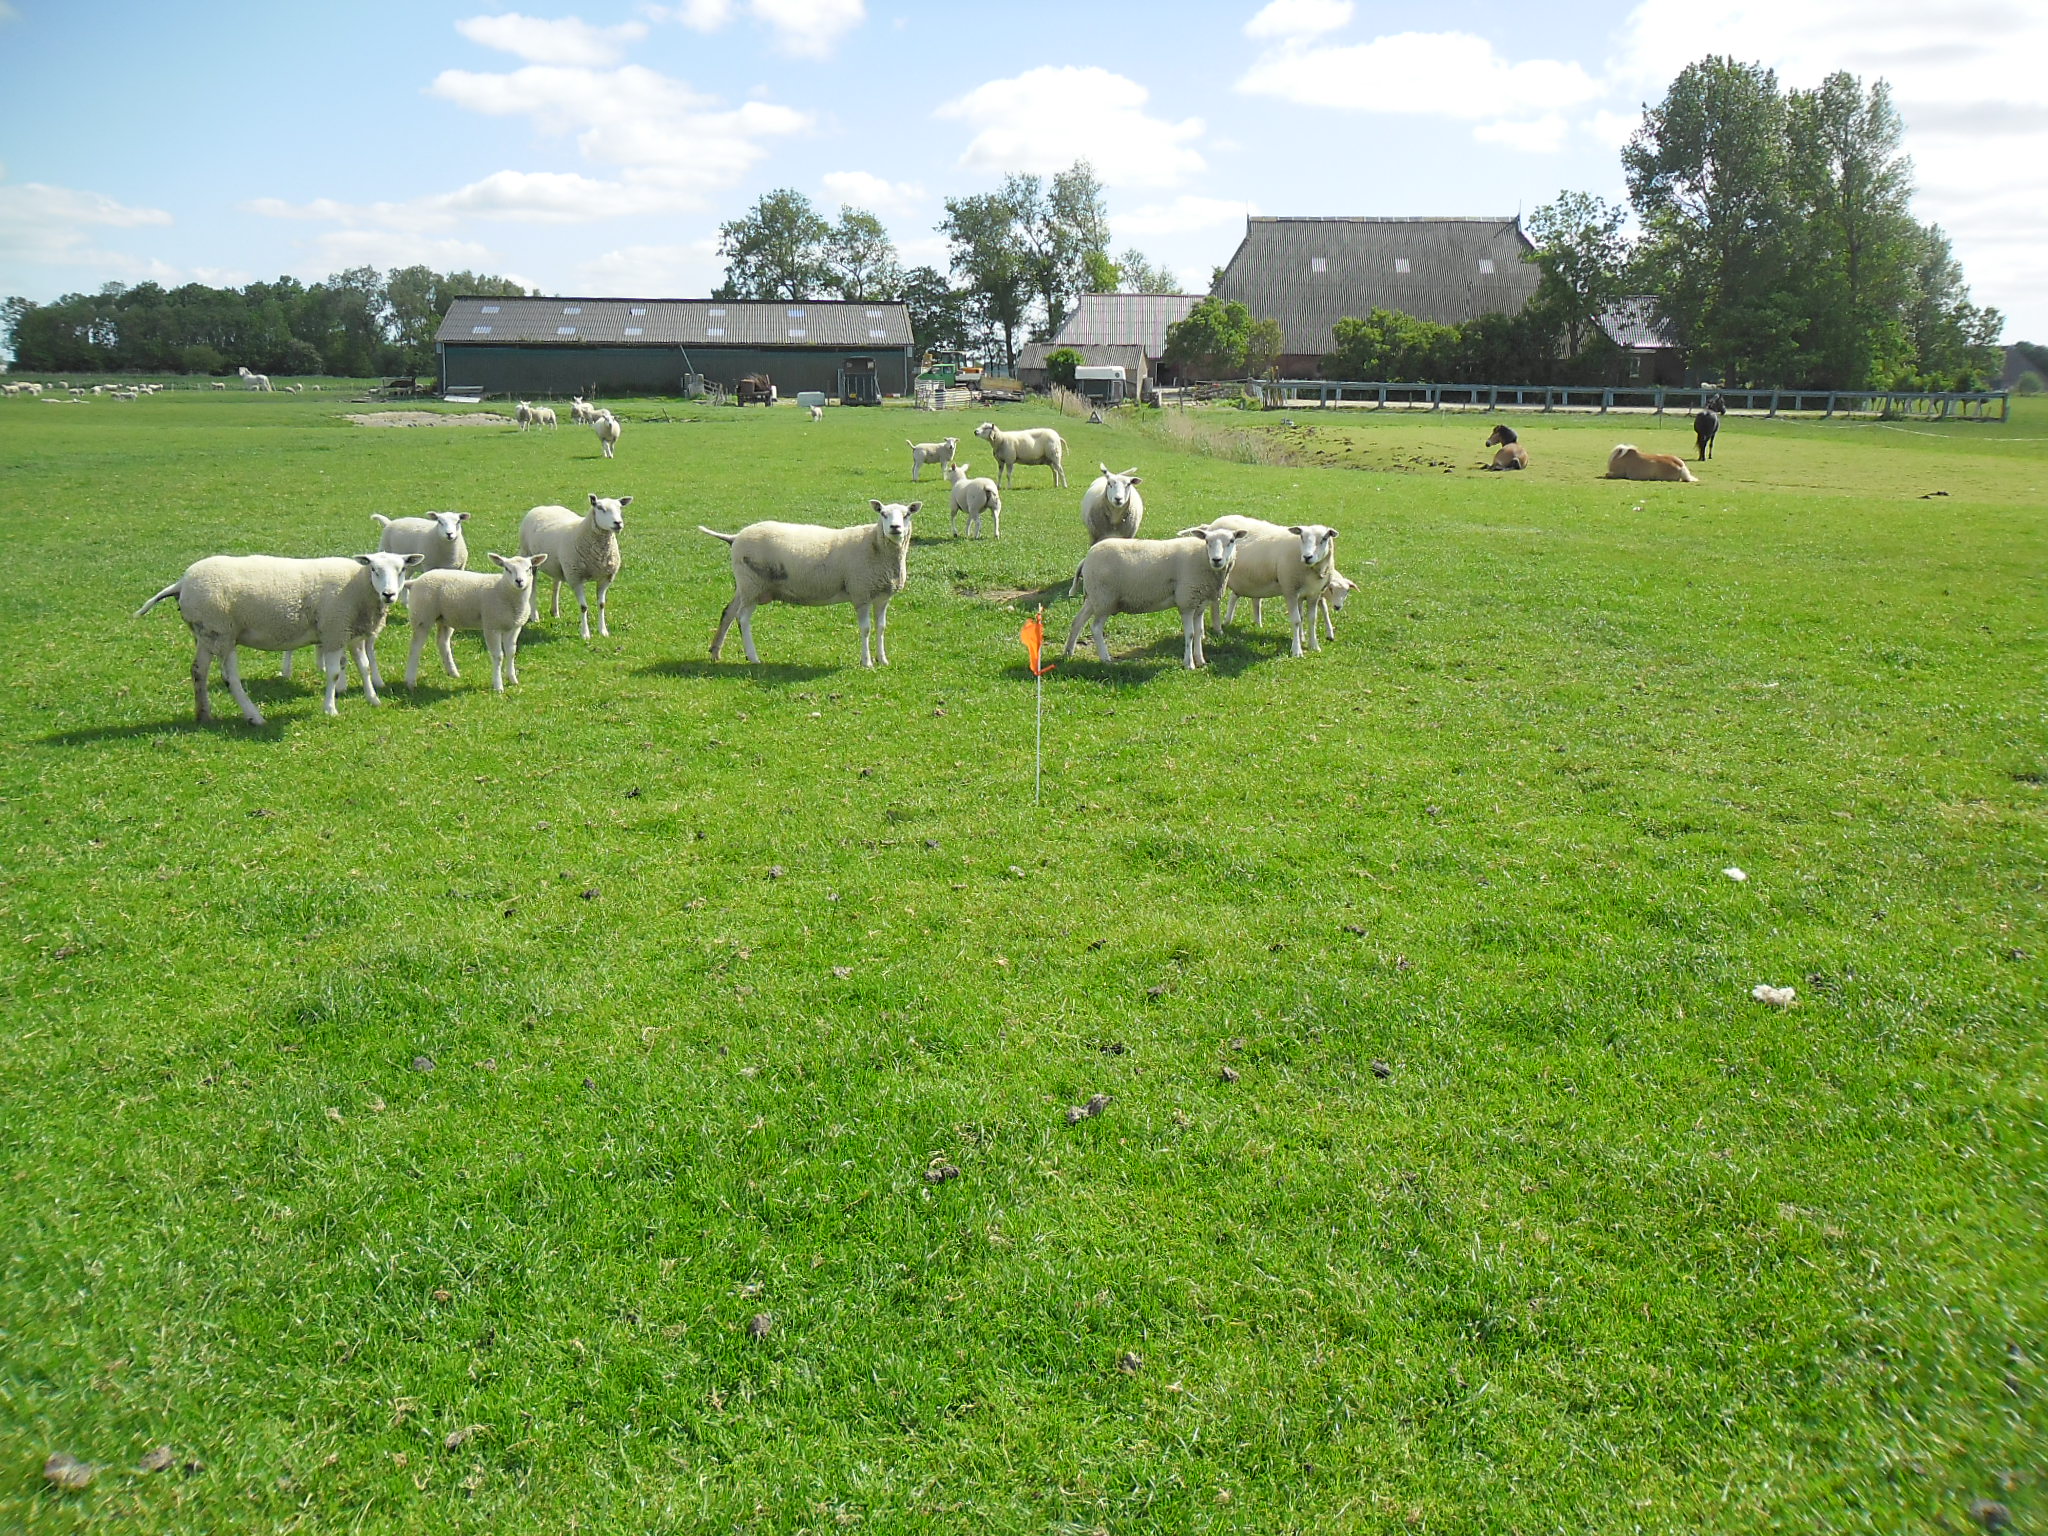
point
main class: Grassland
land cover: Grassland without tree/shrub cover
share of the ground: > 75 %
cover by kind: herbaceous plants 100 %
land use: Agriculture (excluding fallow land and kitchen gardens)
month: June
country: NL
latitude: 53.2123
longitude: 5.5515
